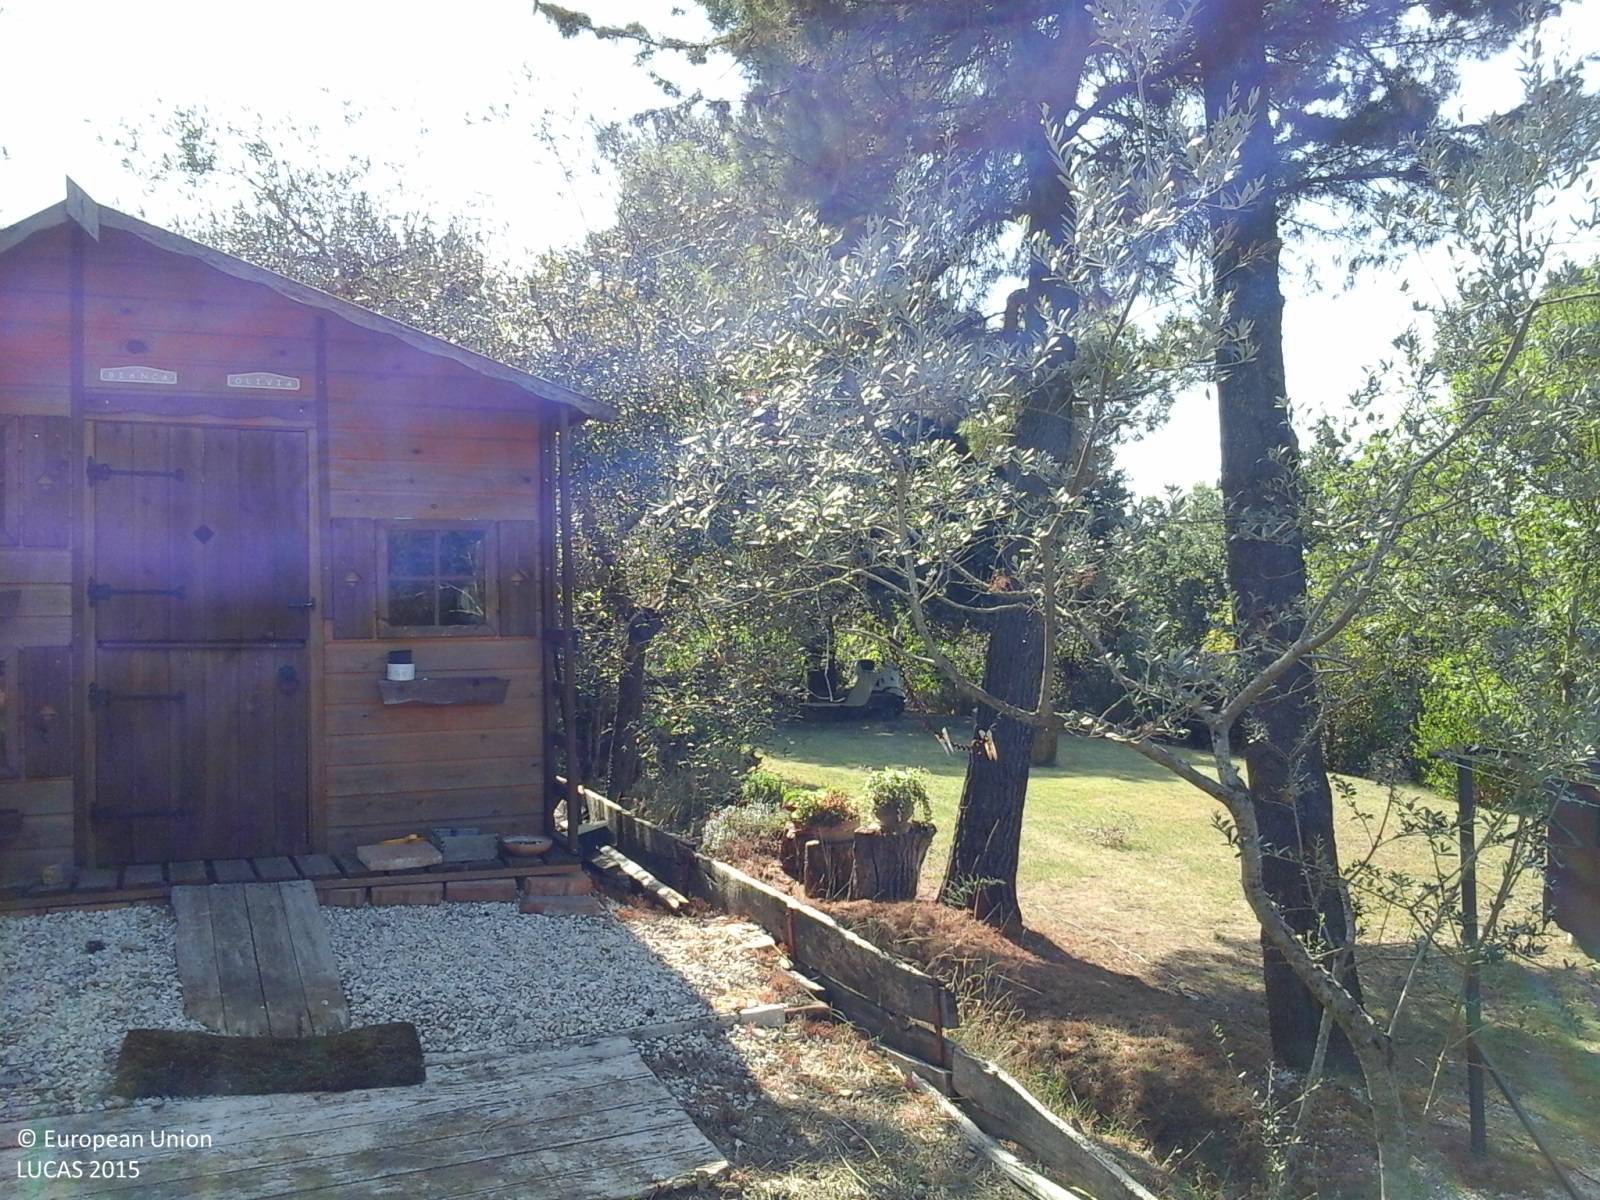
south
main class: Cropland
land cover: Olive groves
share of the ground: > 75 %
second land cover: Grassland without tree/shrub cover
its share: > 75 %
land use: Agriculture (excluding fallow land and kitchen gardens)
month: September
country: IT
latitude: 43.0814
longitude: 12.2167
